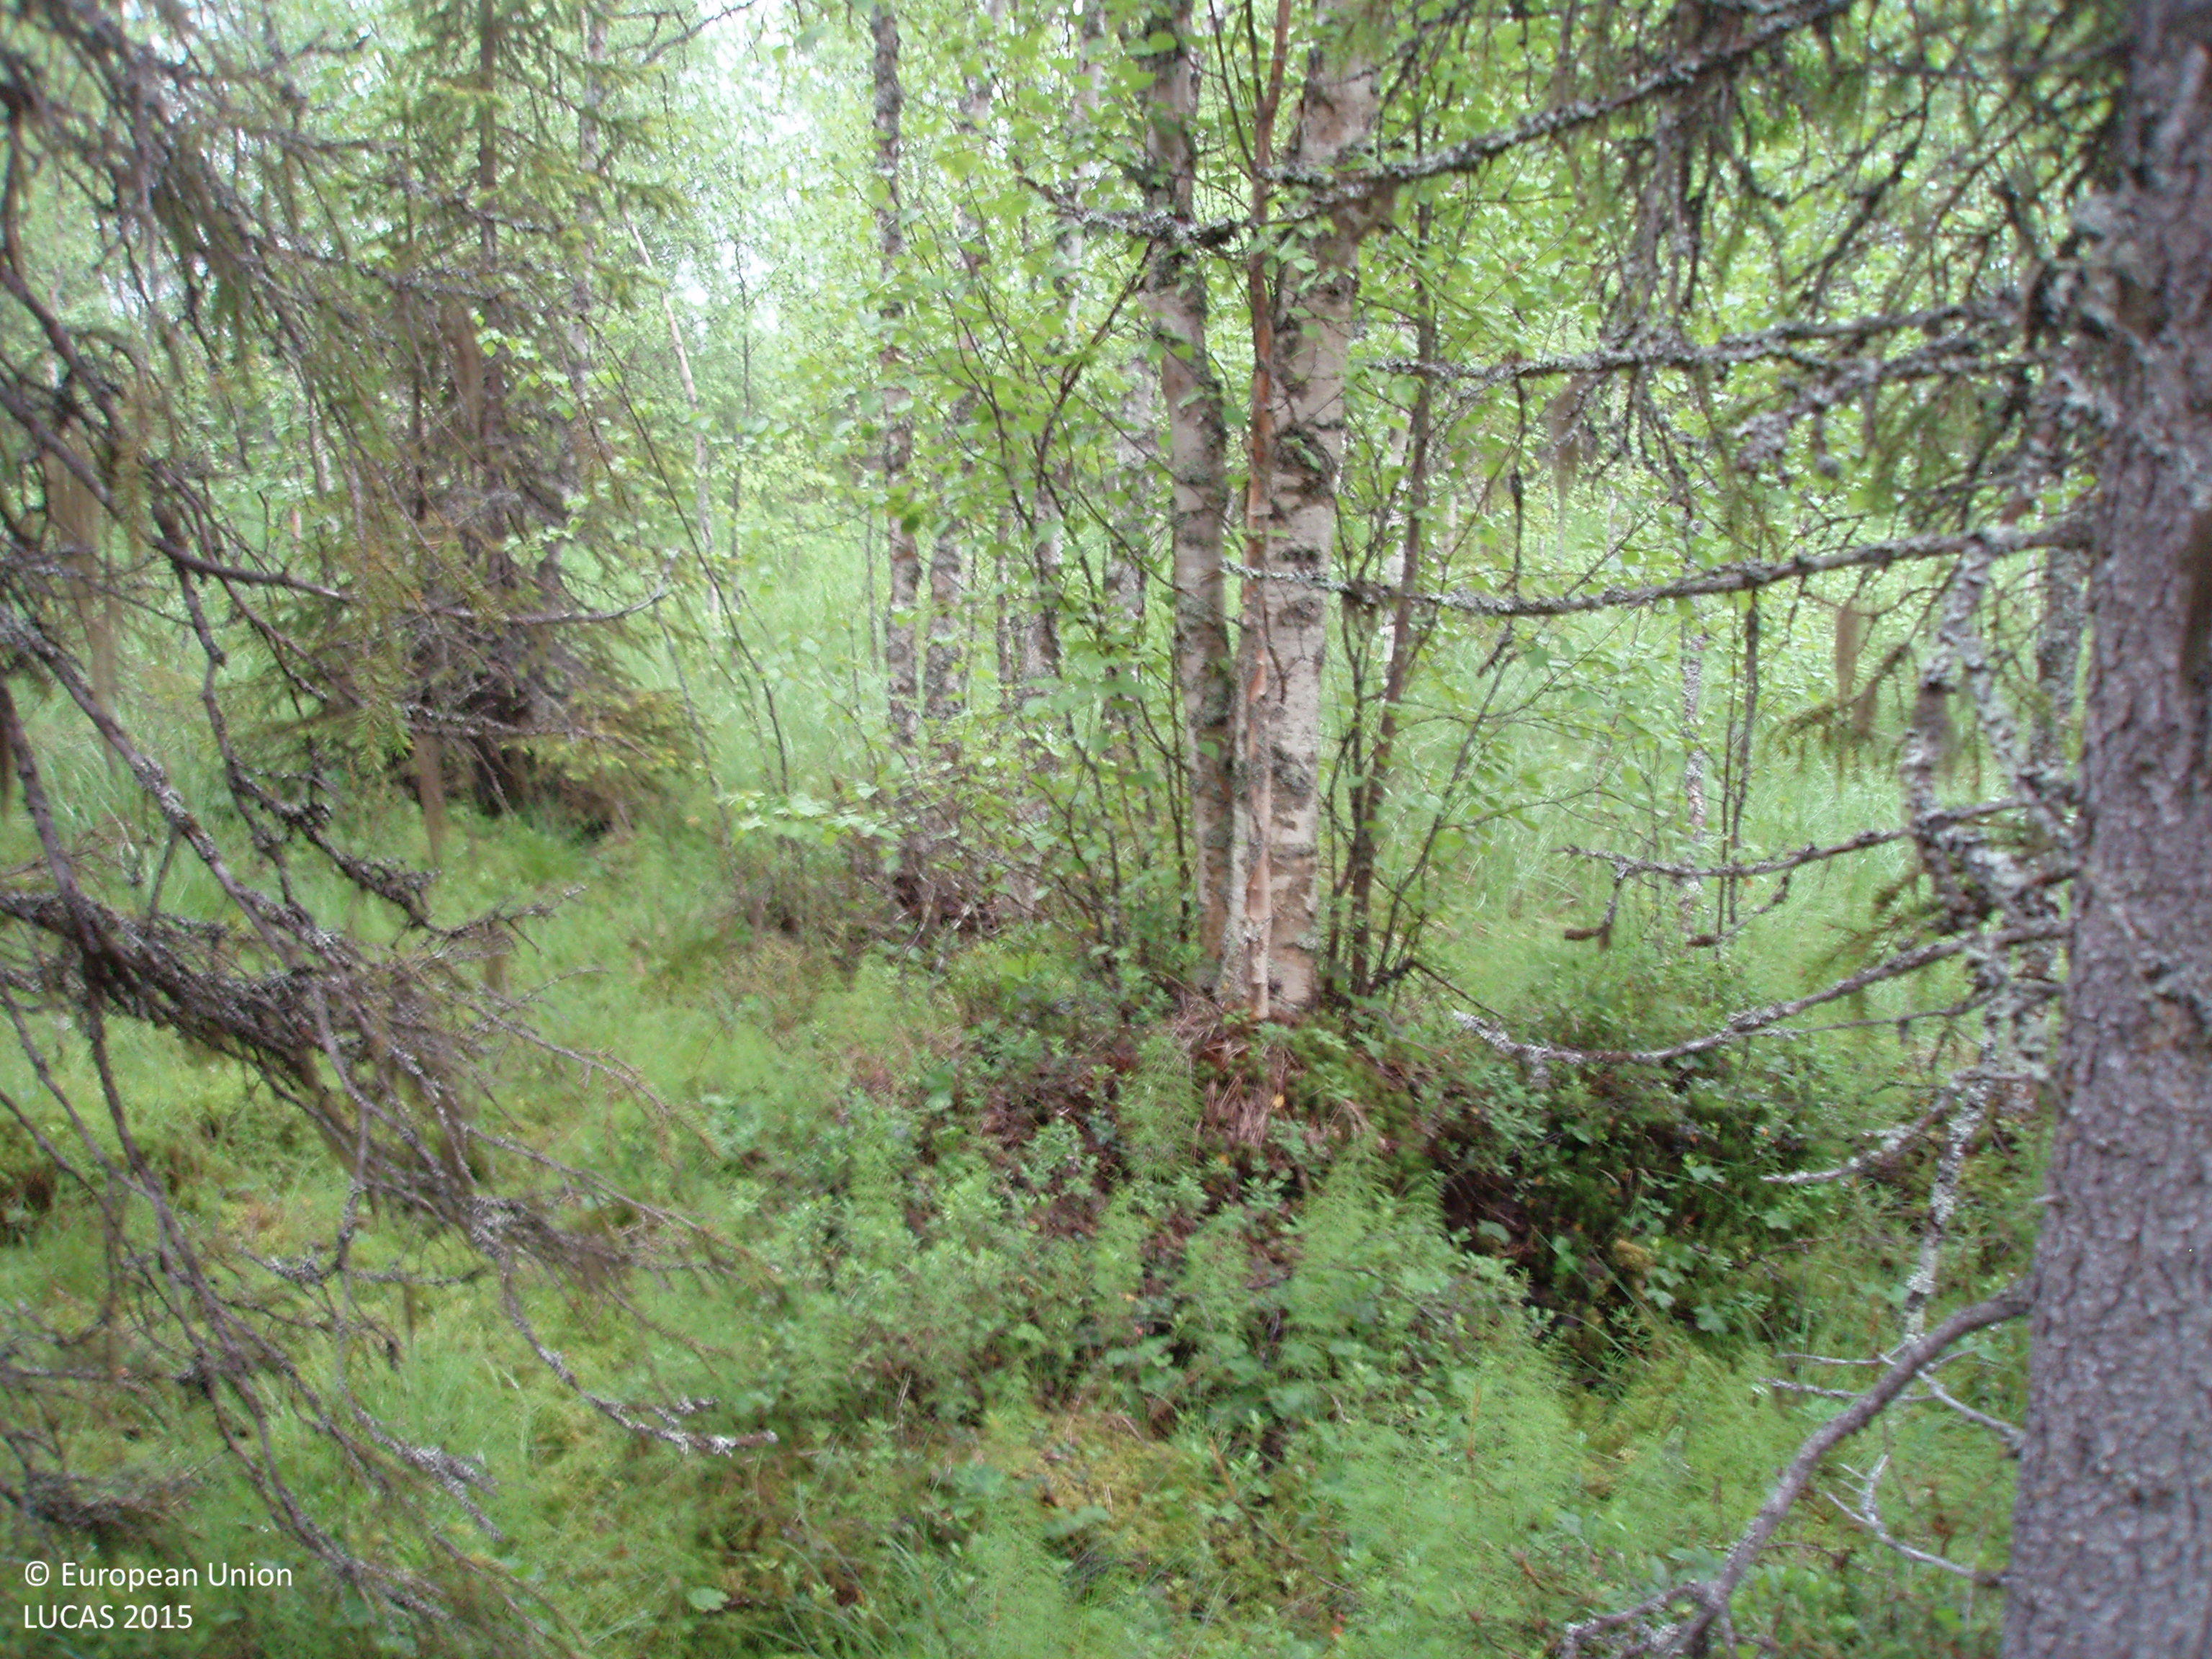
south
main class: Woodland
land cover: Spruce dominated mixed woodland
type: boreal forest
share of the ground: 50 - 75 %
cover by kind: coniferous forest trees 40 %, broadleaved forest trees 20 %, shrubs 20 %, herbaceous plants 20 %
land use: Forestry
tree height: > 5 m
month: July
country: FI
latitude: 67.2714
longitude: 28.2381
